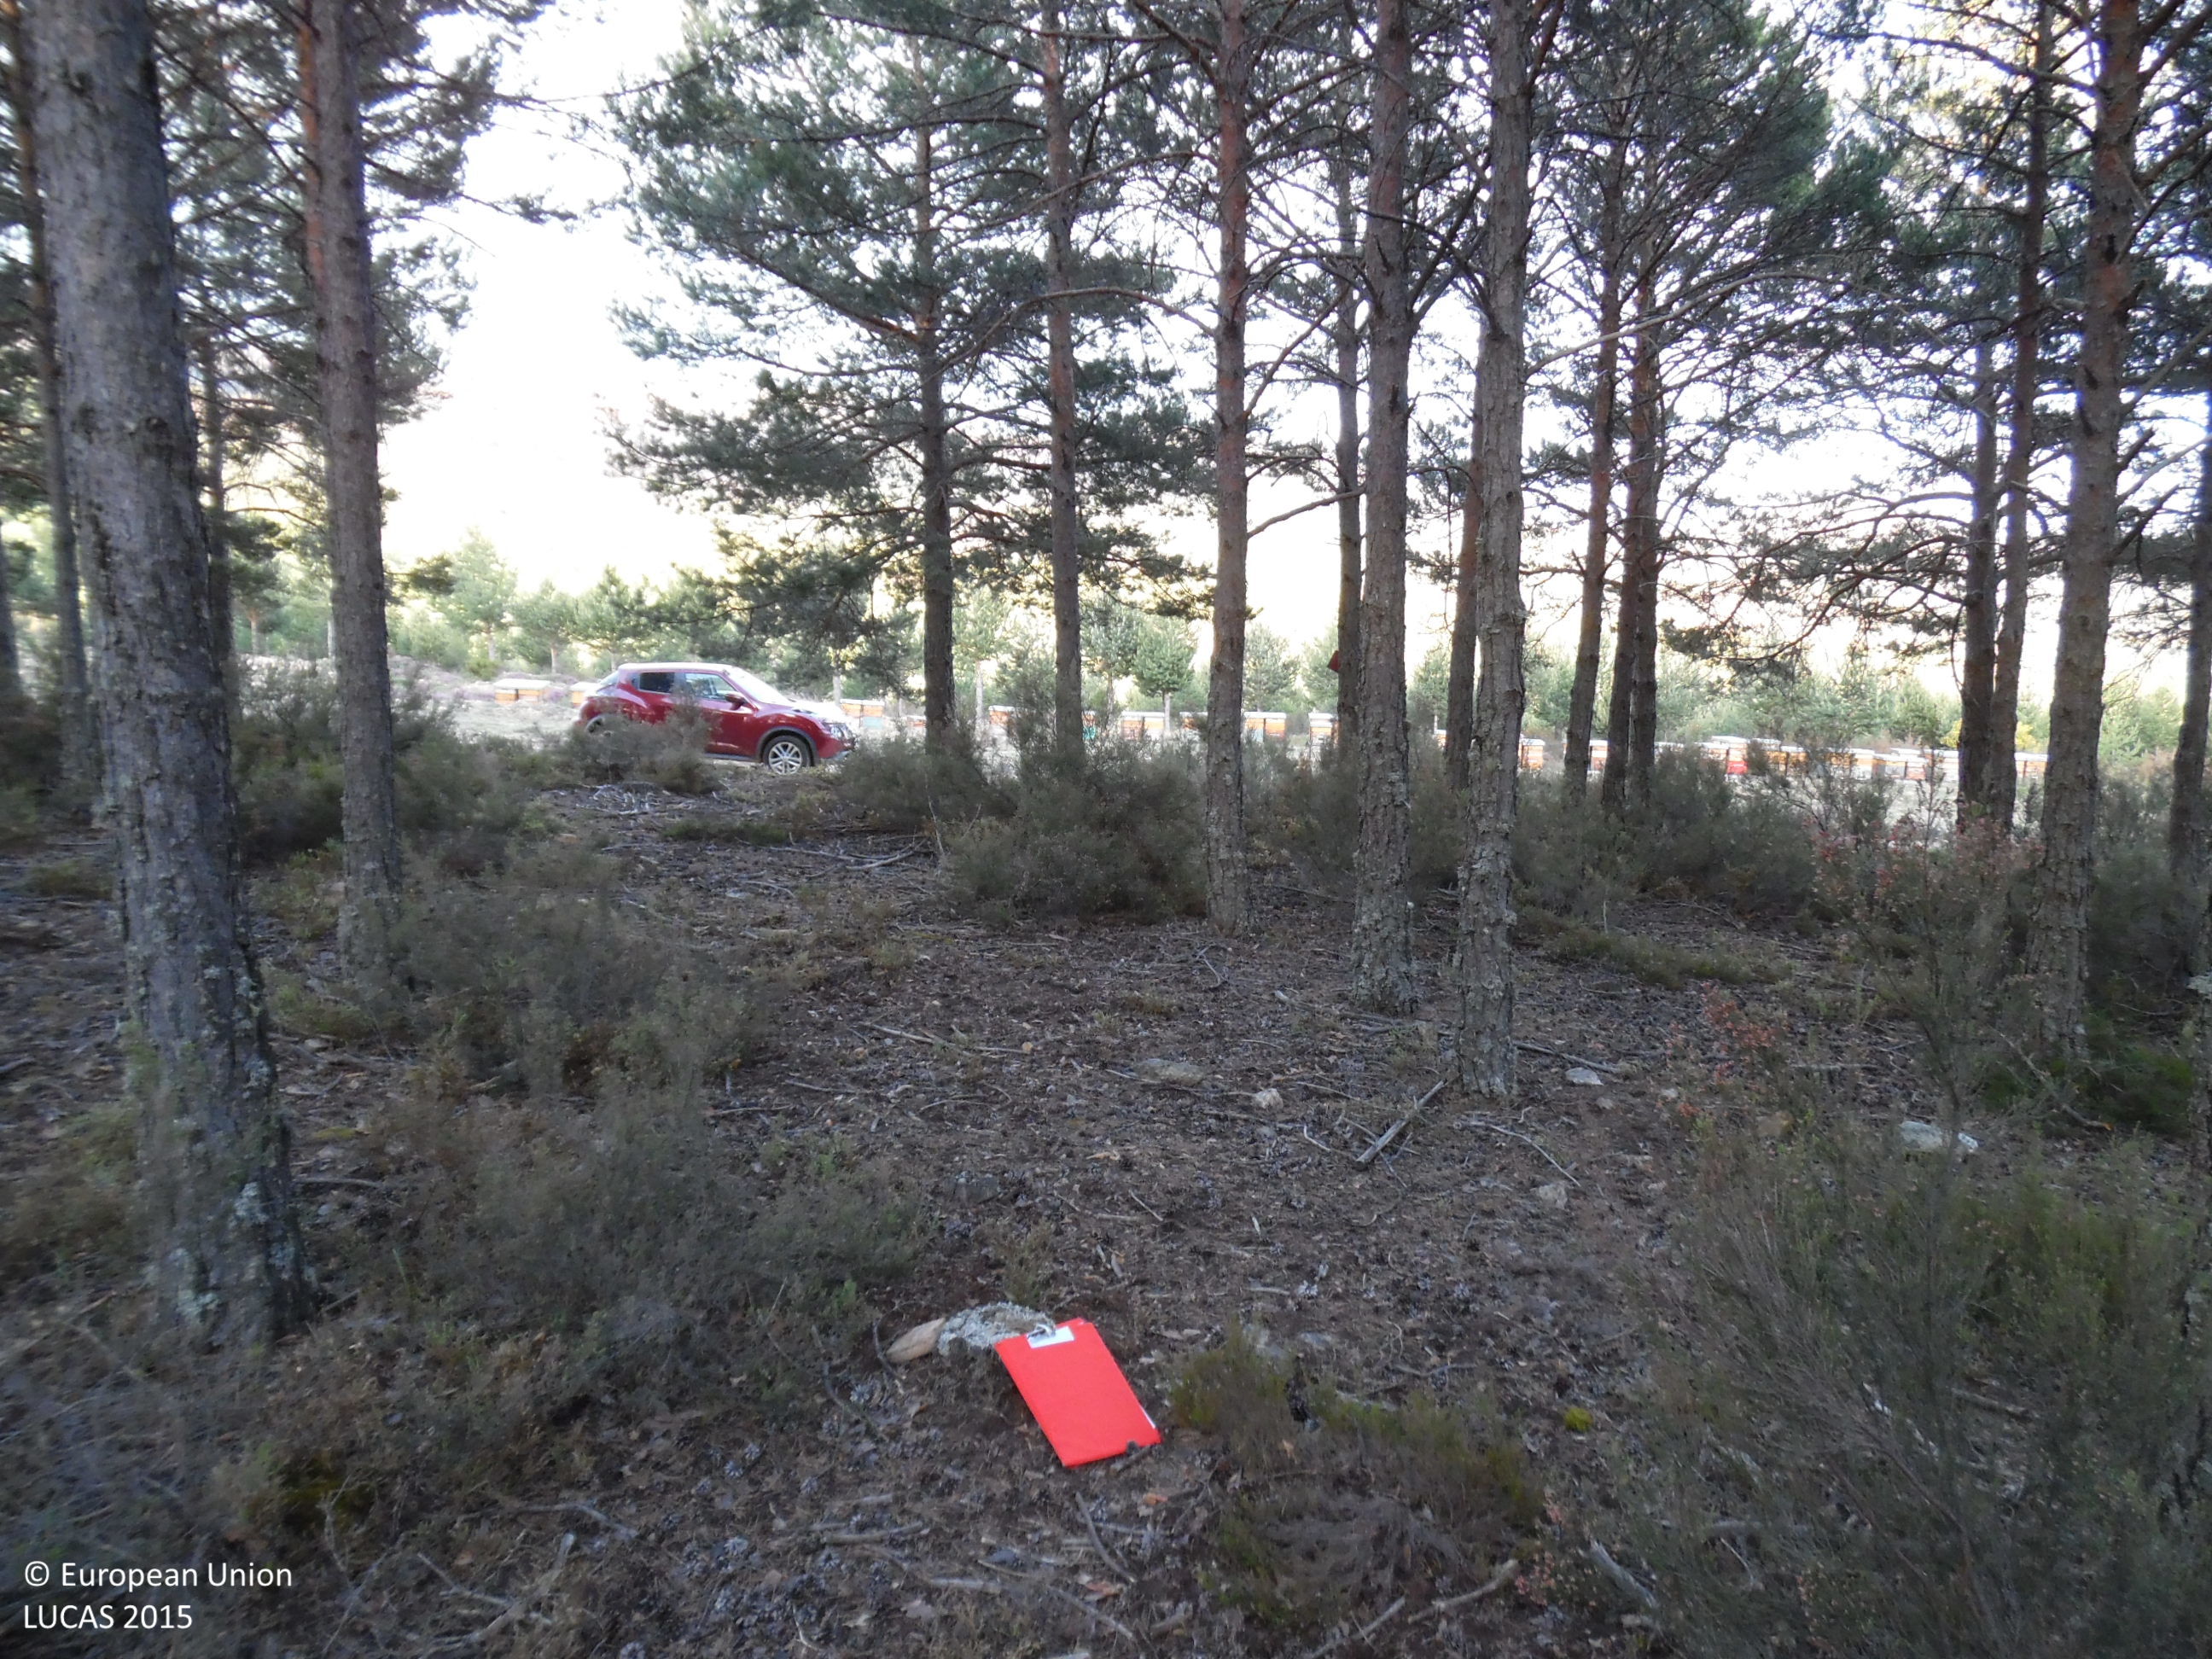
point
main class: Woodland
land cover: Pine dominated coniferous woodland
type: coniferous forest of the mediterranean region
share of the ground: > 75 %
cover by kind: coniferous forest trees 100 %
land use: Forestry
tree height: > 5 m
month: May
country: ES
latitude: 42.2621
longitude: -6.2924
